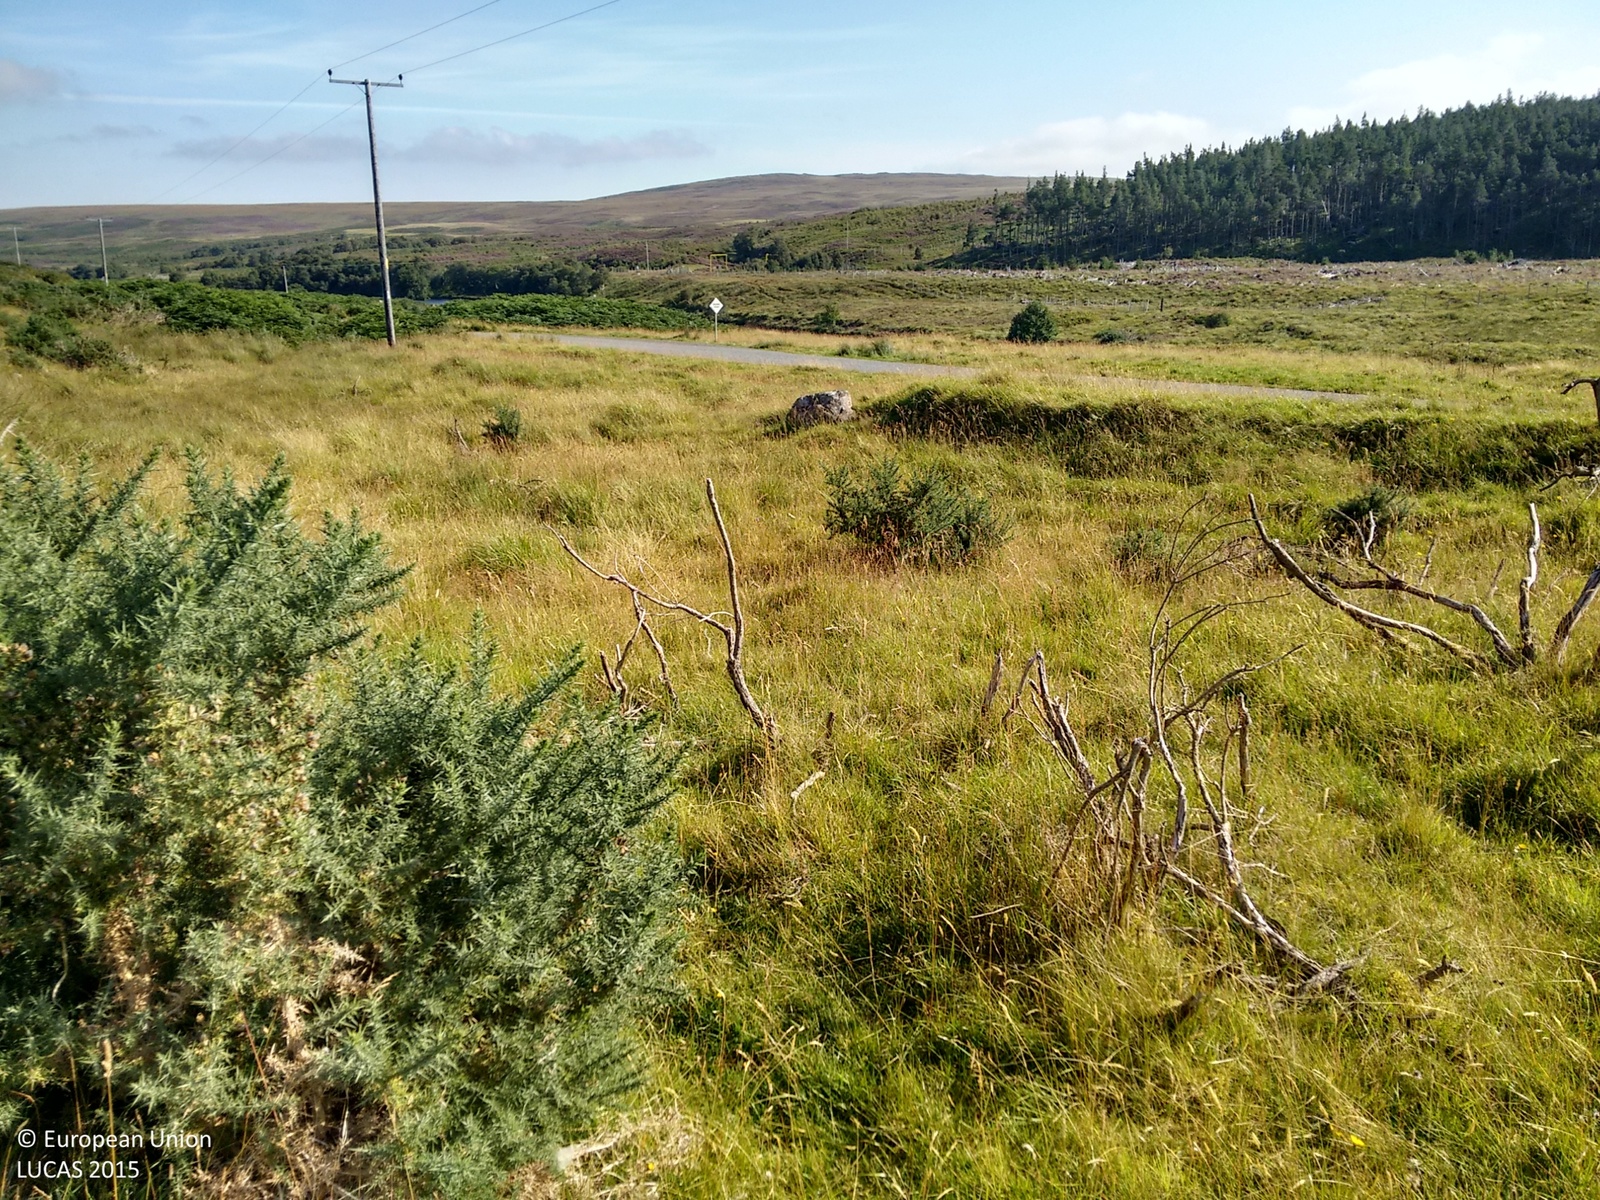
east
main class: Woodland
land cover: Pine dominated coniferous woodland
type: hemiboreal forest and nemoral coniferous forest and mixed broadleaved-coniferous forest
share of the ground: > 75 %
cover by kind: coniferous forest trees 100 %
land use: Forestry
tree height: > 5 m
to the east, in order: Pine dominated coniferous woodland; Grassland without tree/shrub cover; Fences; Grassland without tree/shrub cover; Ditches and canals; Electric lines; Grass margins; Paved roads, cycling and walking lanes; Grassland without tree/shrub cover; Inland fresh running water; Grassland with sparse tree/shrub cover
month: September
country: GB
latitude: 58.3525
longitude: -4.2461
